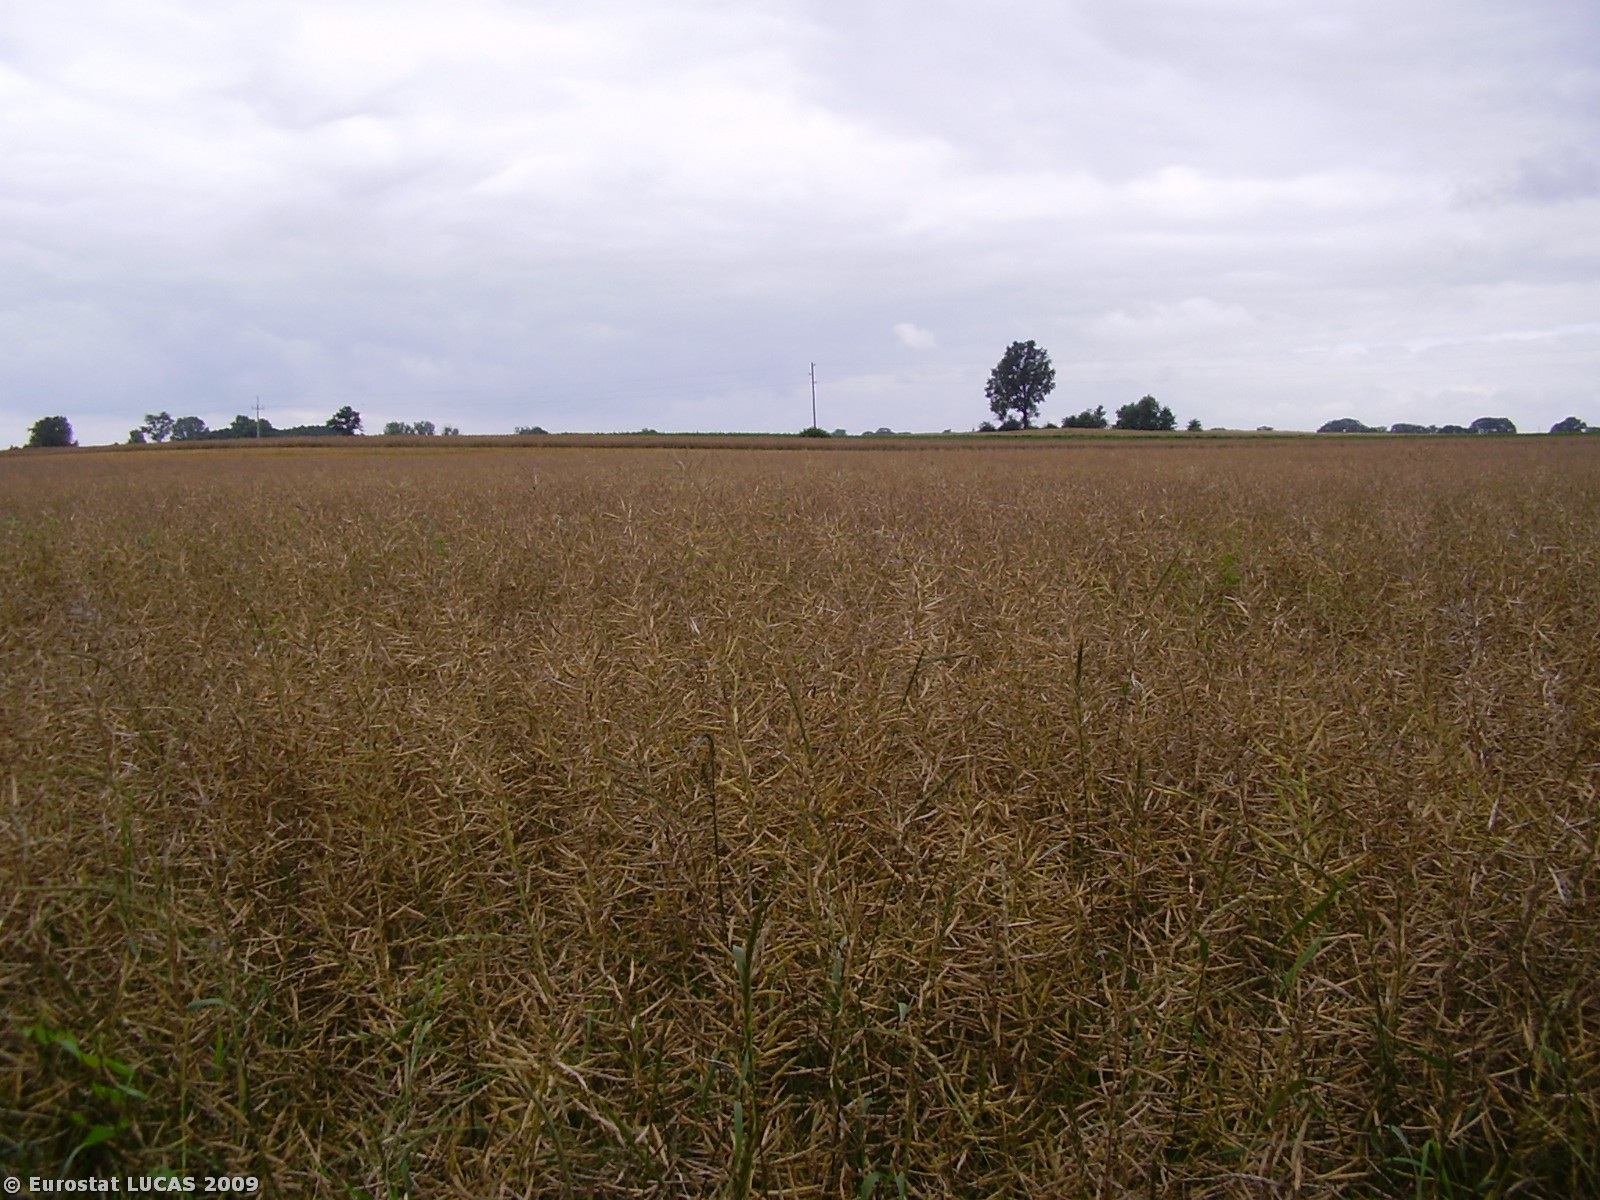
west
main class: Cropland
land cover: Rape and turnip rape
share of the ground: > 75 %
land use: Agriculture (excluding fallow land and kitchen gardens)
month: July
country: PL
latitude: 51.1901
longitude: 17.6688
